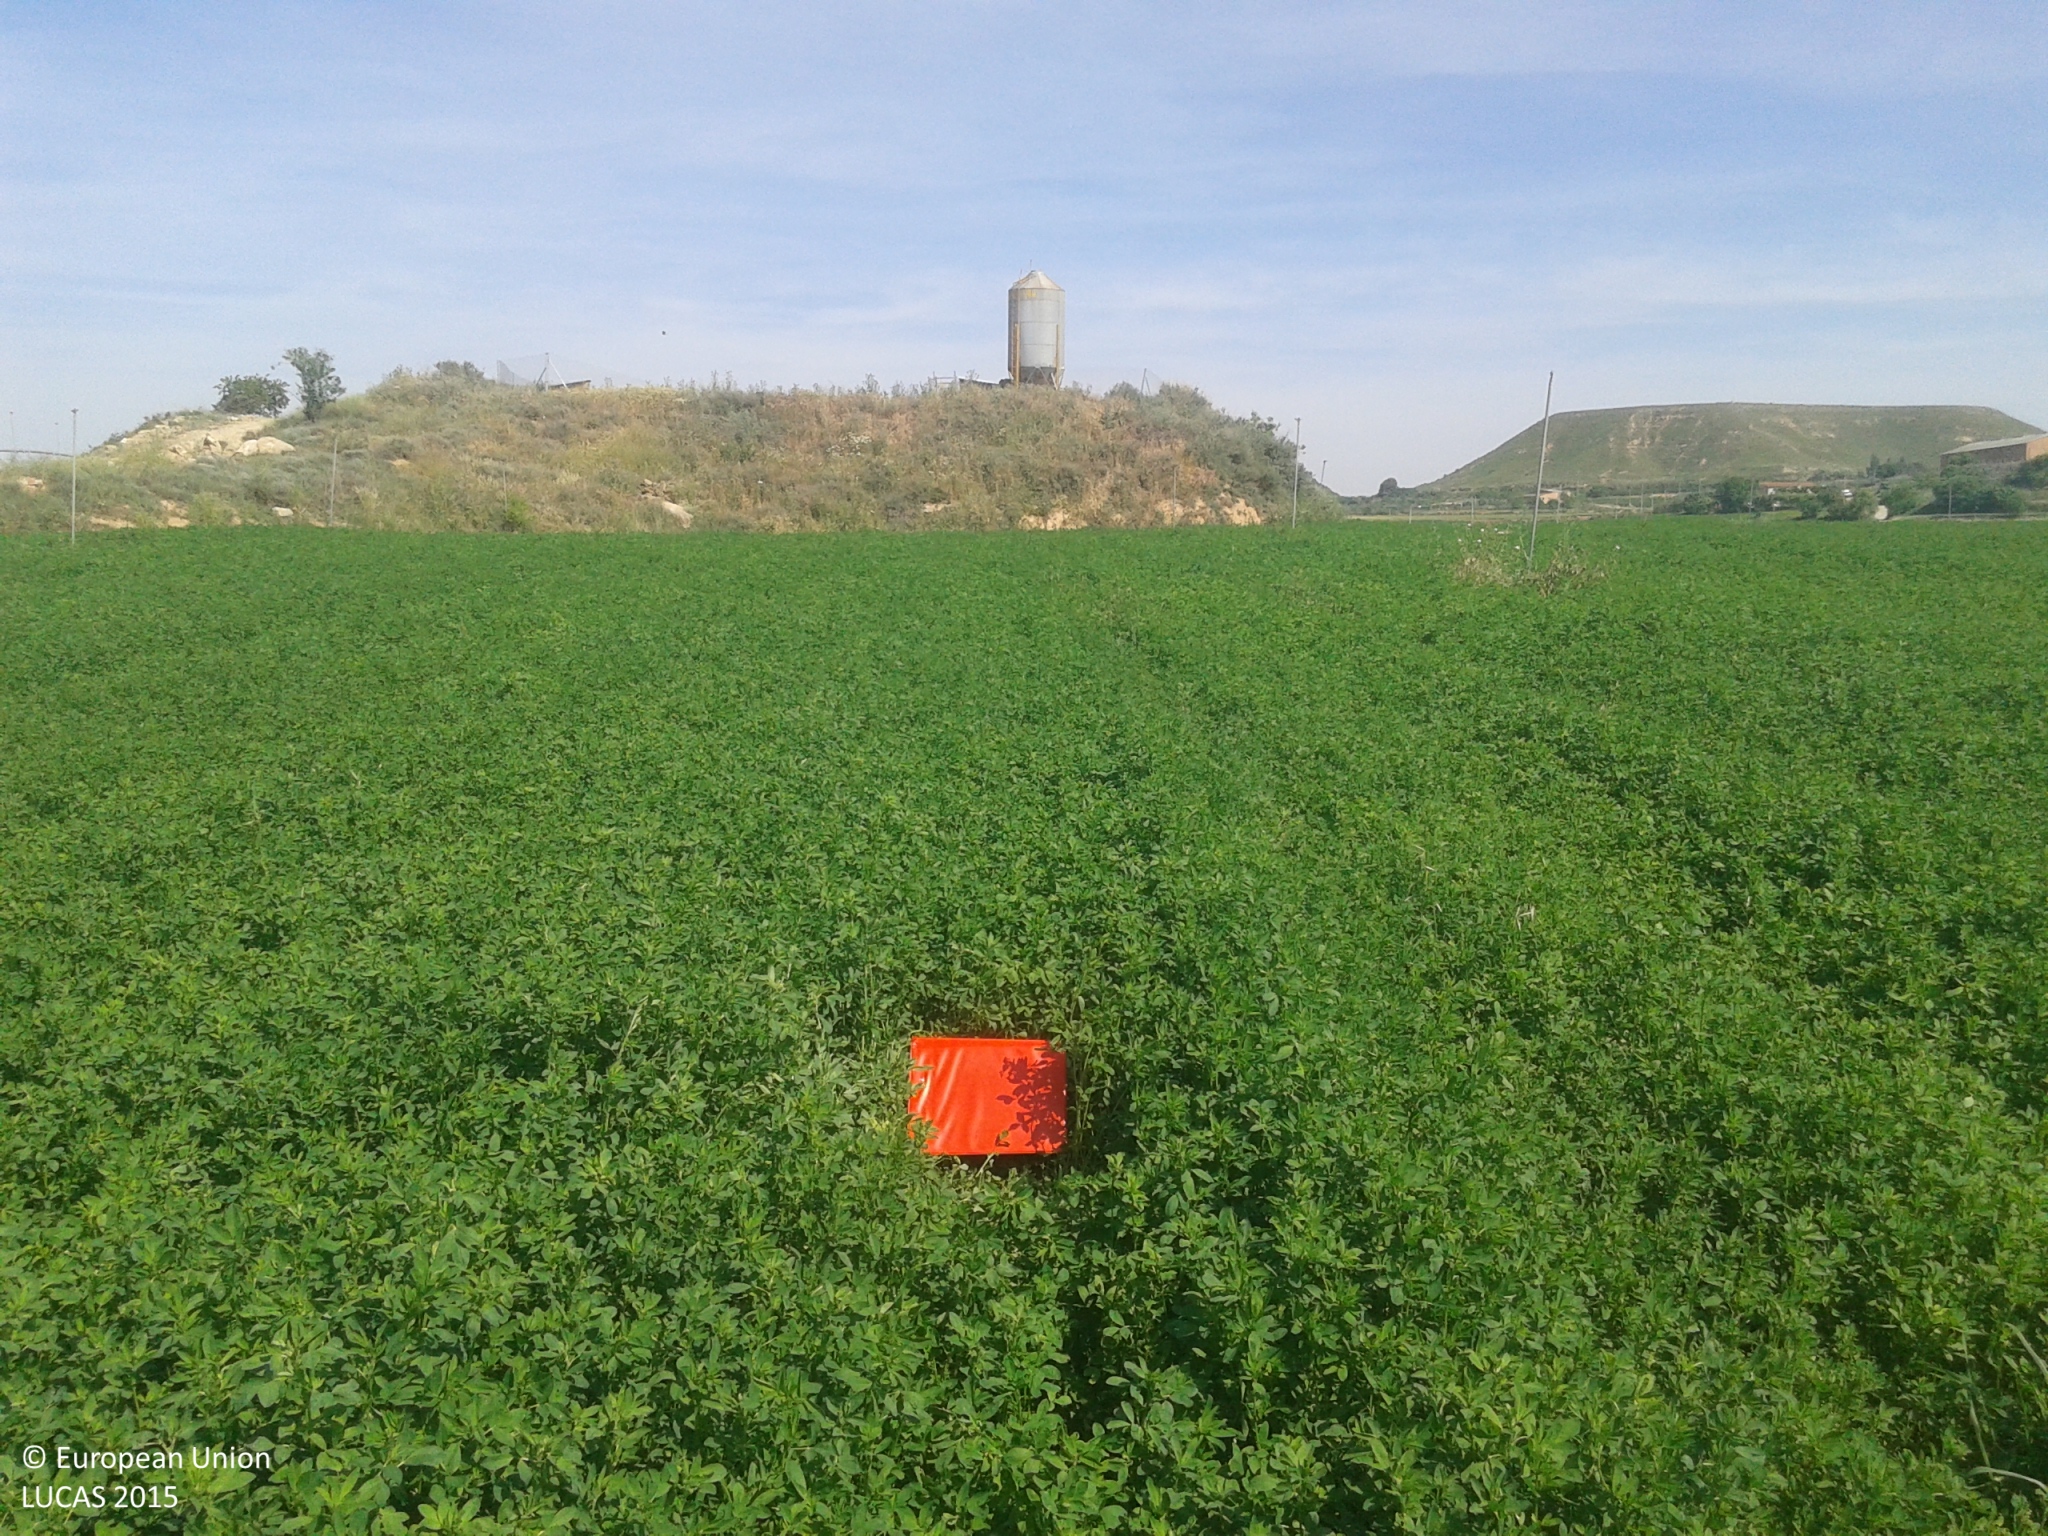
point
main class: Cropland
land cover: Lucerne
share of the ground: > 75 %
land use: Agriculture (excluding fallow land and kitchen gardens)
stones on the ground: < 10 %
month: May
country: ES
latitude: 41.8079
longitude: 0.5128
